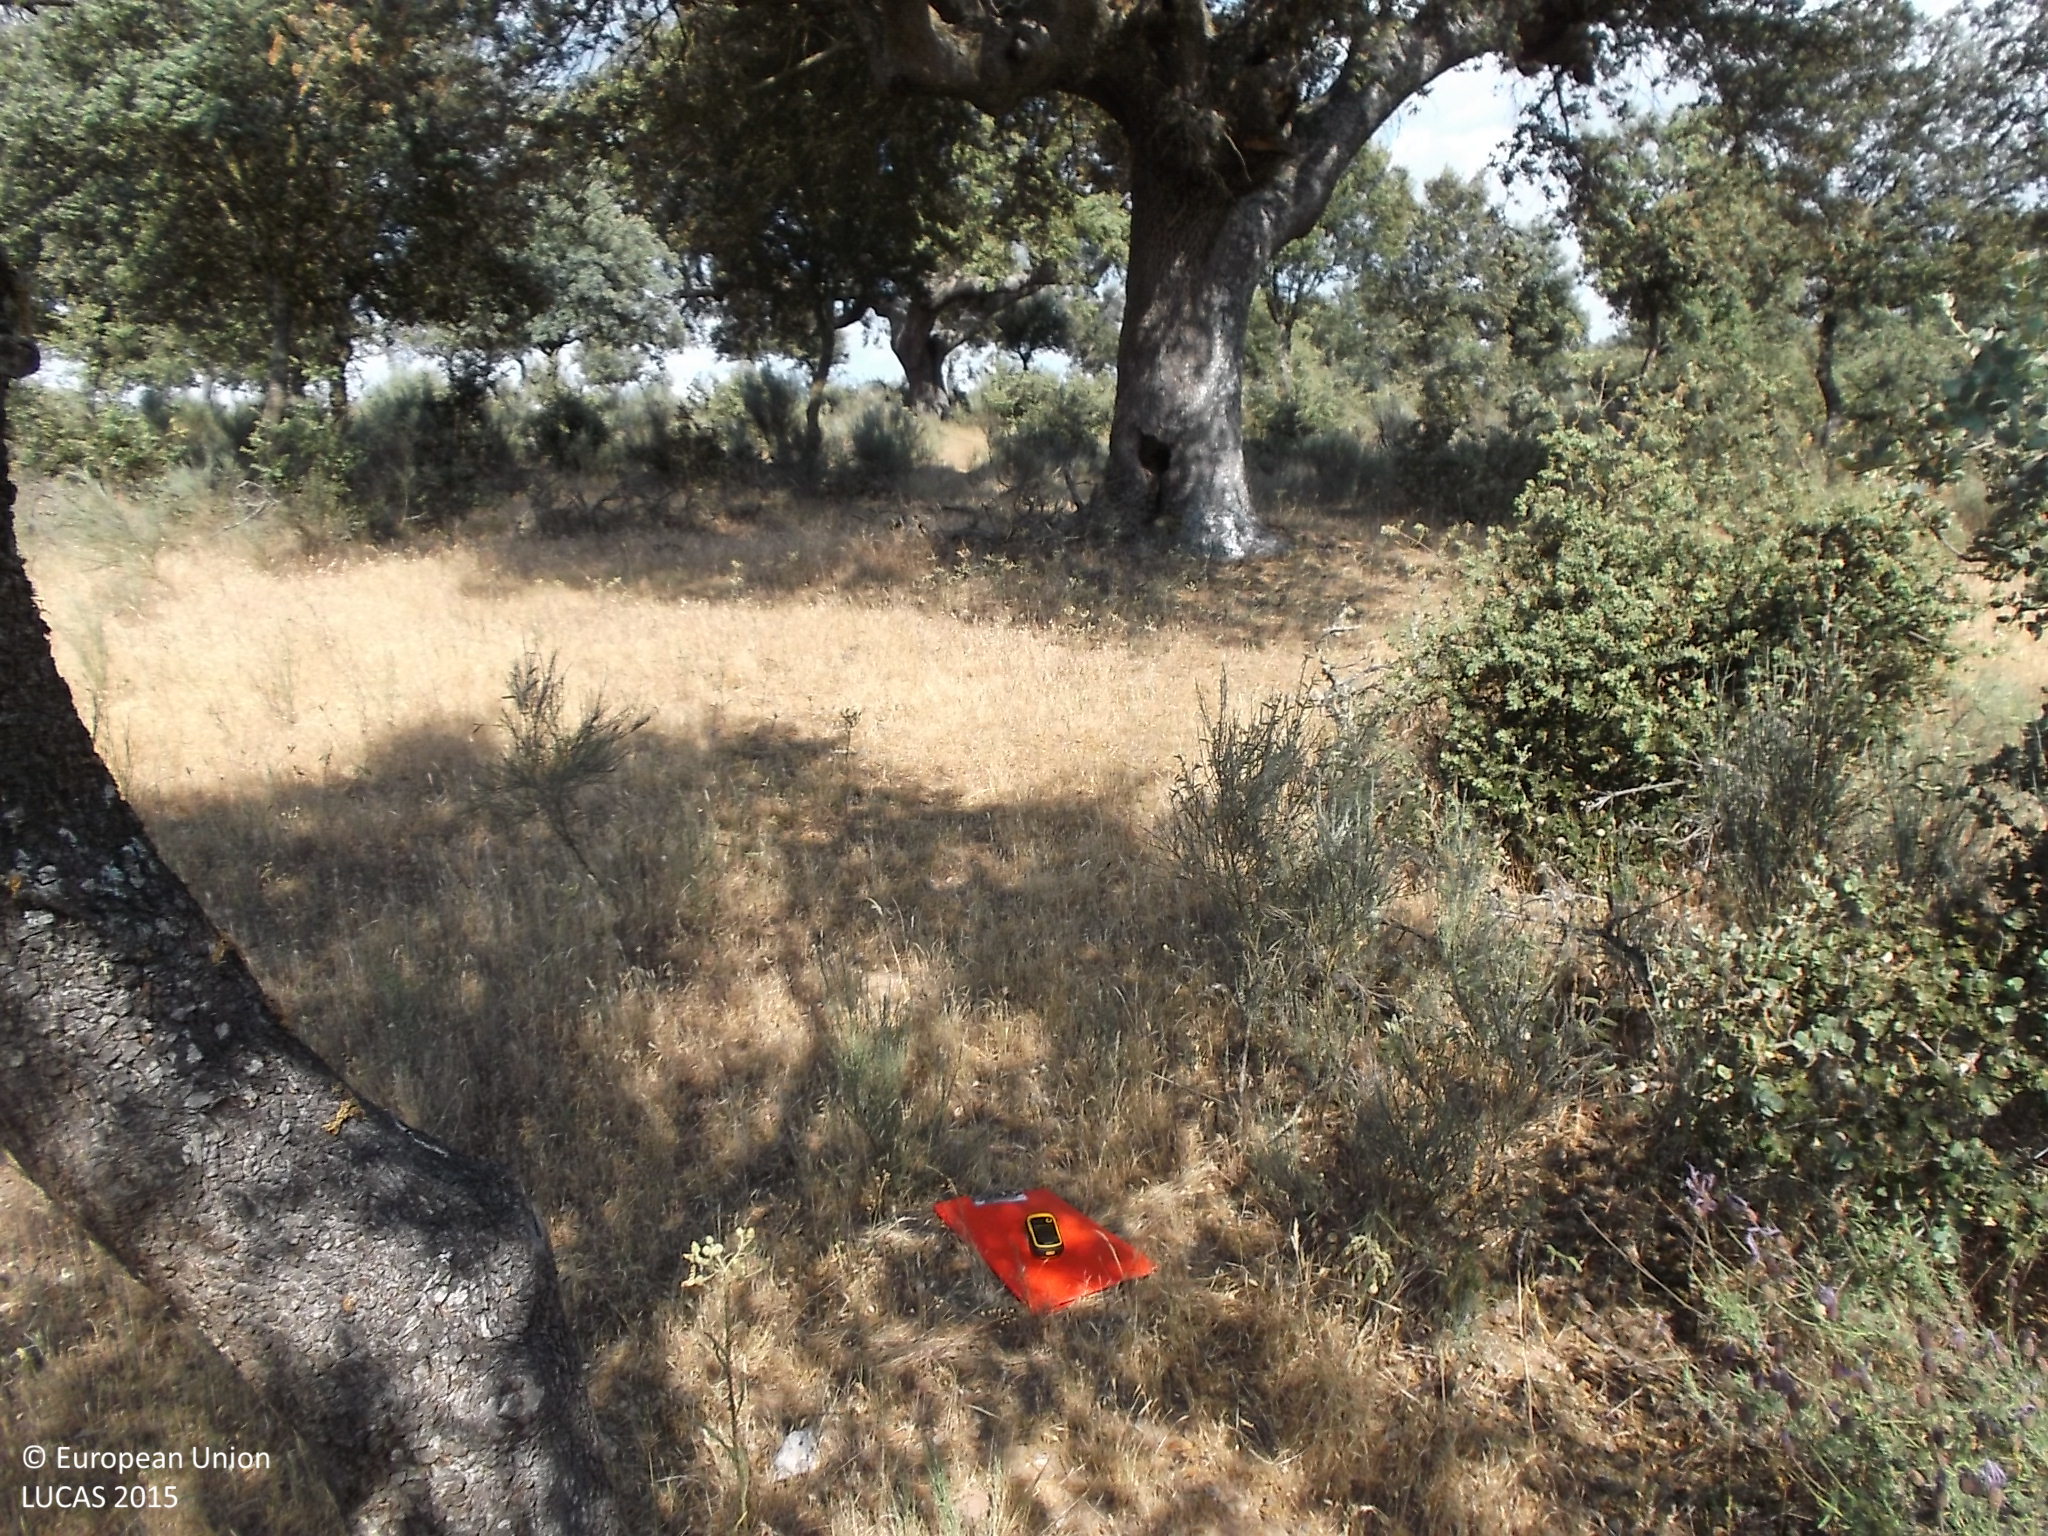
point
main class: Woodland
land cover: Broadleaved woodland
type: thermophilous deciduous forest
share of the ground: 10 - 25 %
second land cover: Shrubland without tree cover
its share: 50 - 75 %
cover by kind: shrubs 50 %, herbaceous plants 35 %, broadleaved forest trees 15 %
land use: Forestry
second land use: Agriculture (excluding fallow land and kitchen gardens)
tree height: > 5 m
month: June
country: ES
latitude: 40.8604
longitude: -6.4276
